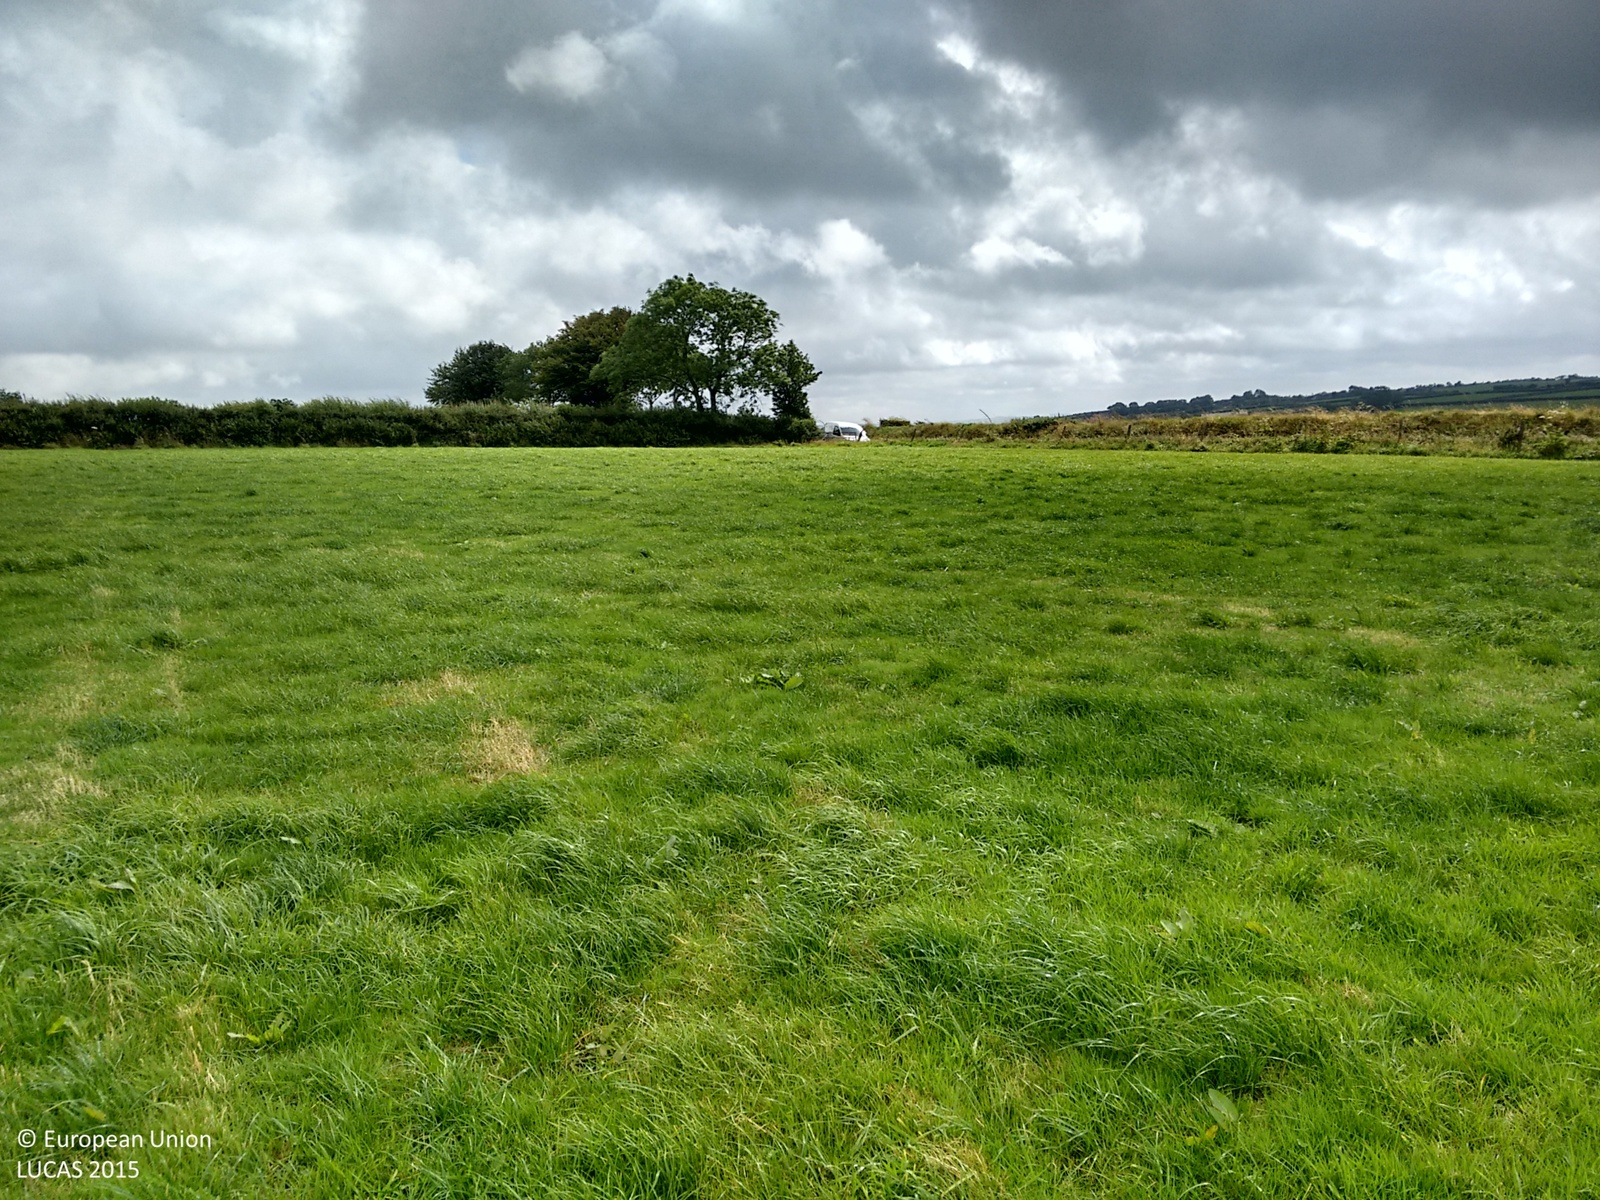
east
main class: Grassland
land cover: Grassland without tree/shrub cover
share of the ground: > 75 %
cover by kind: herbaceous plants 100 %
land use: Agriculture (excluding fallow land and kitchen gardens)
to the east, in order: Grassland without tree/shrub cover; Fences; Grass margins; Tracks; Shruby margins; Fences; Grassland without tree/shrub cover; Fences; Managed hedges; Grass margins; Paved roads, cycling and walking lanes; Managed hedges; Fences; Grassland without tree/shrub cover
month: August
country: GB
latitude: 51.9459
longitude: -4.4340
